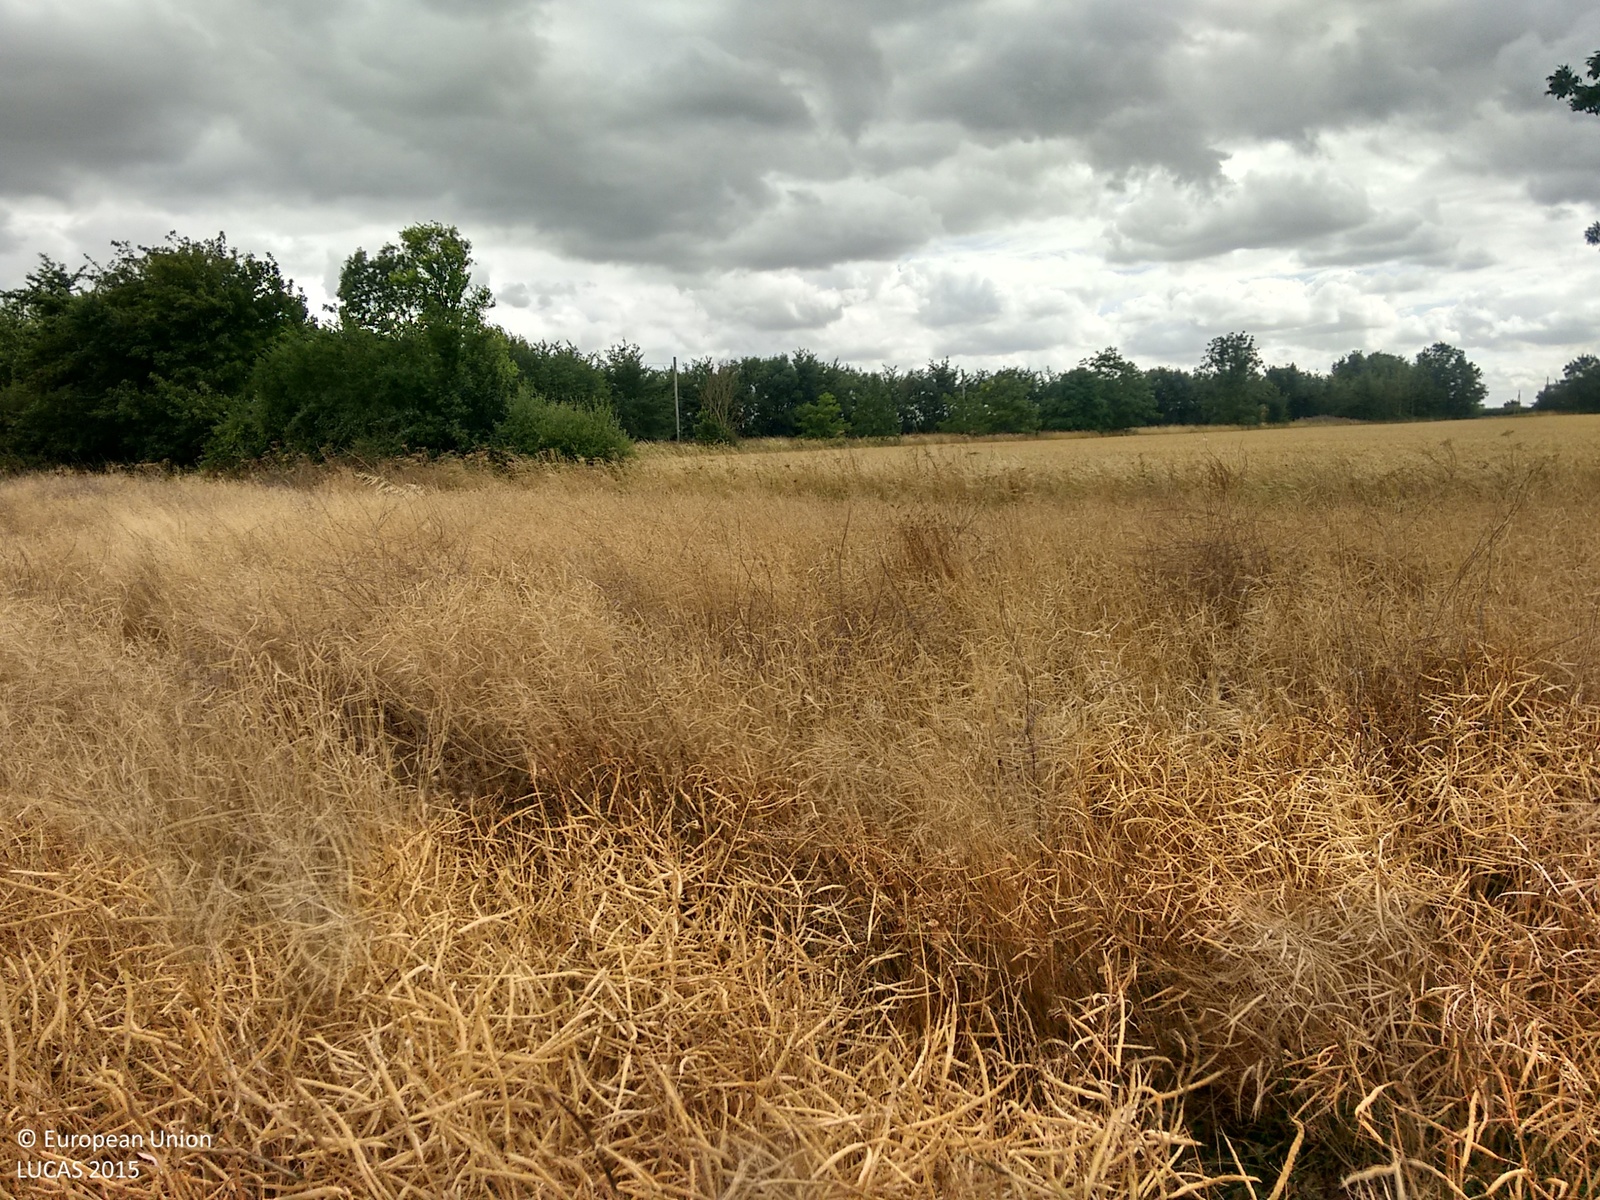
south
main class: Cropland
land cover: Rape and turnip rape
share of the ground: > 75 %
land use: Agriculture (excluding fallow land and kitchen gardens)
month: August
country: GB
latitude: 52.0282
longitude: 0.4543
